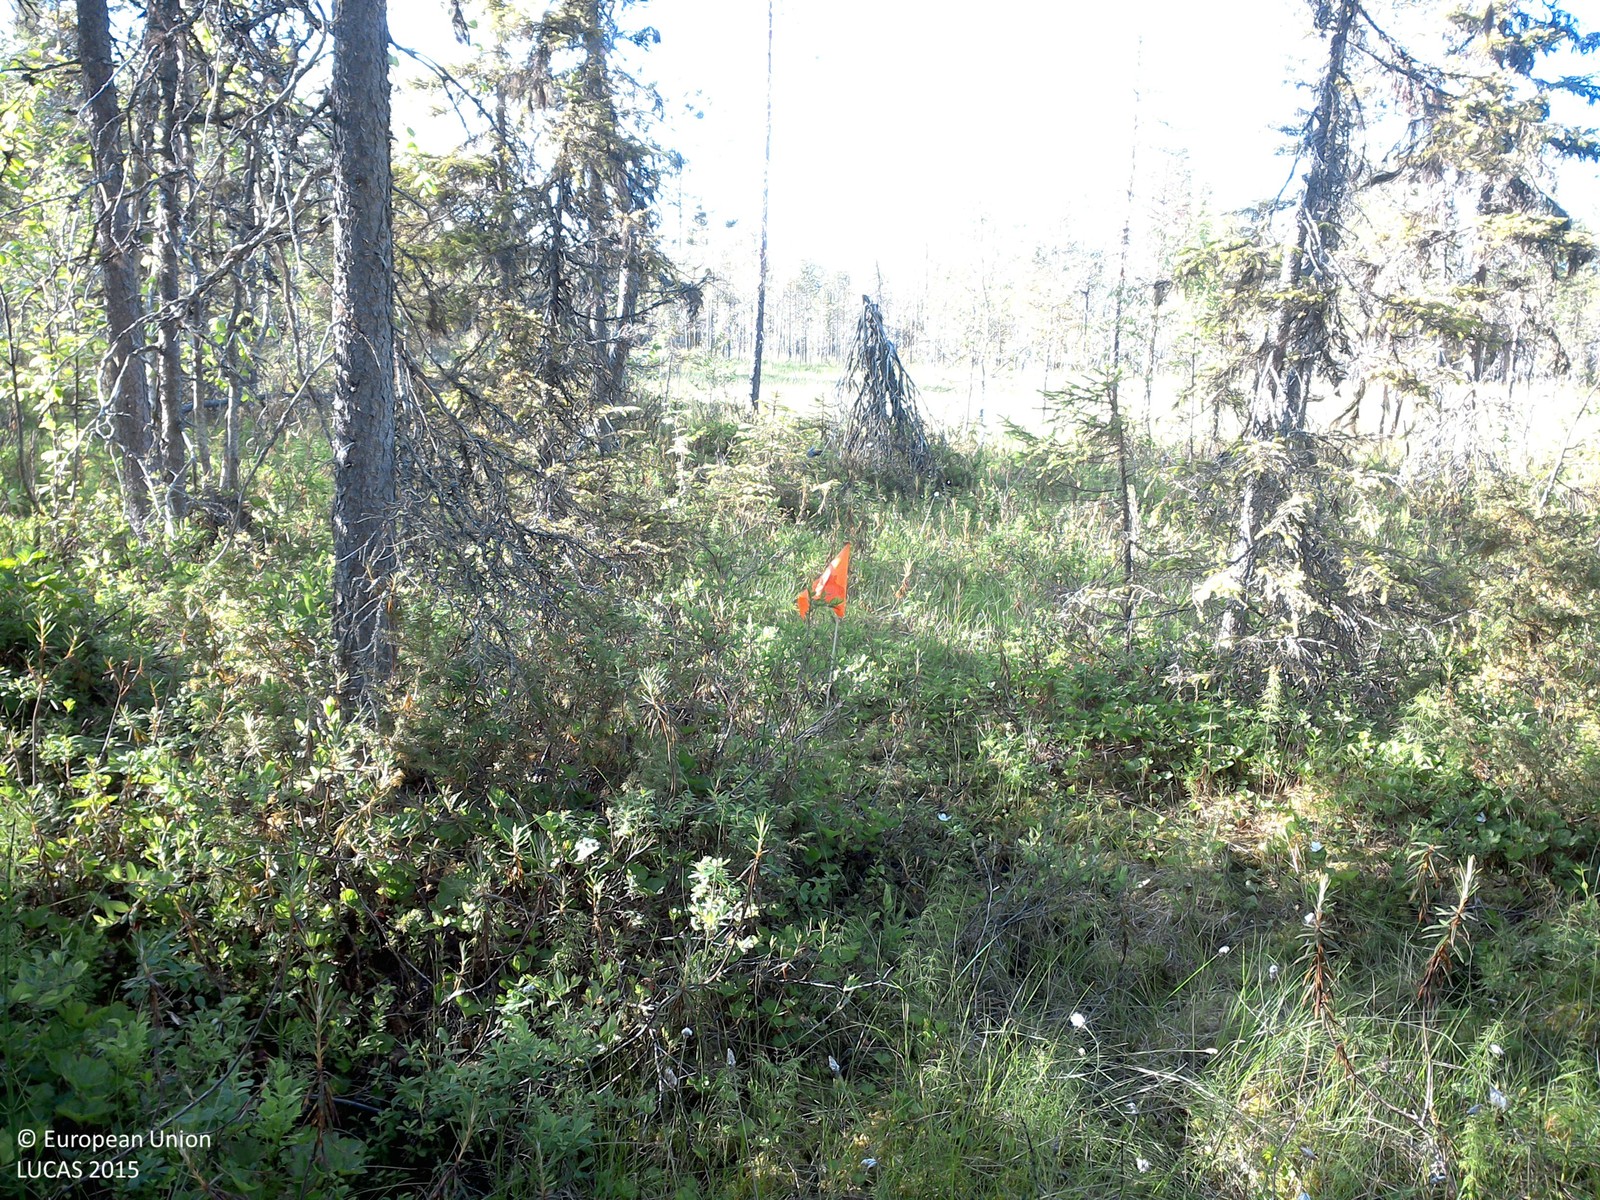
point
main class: Woodland
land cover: Spruce dominated mixed woodland
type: boreal forest
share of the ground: 10 - 25 %
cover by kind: herbaceous plants 35 %, shrubs 30 %, coniferous forest trees 15 %, lichens and mosses 15 %, broadleaved forest trees 5 %
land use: Forestry
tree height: > 5 m
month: July
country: SE
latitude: 66.7211
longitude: 23.5641
